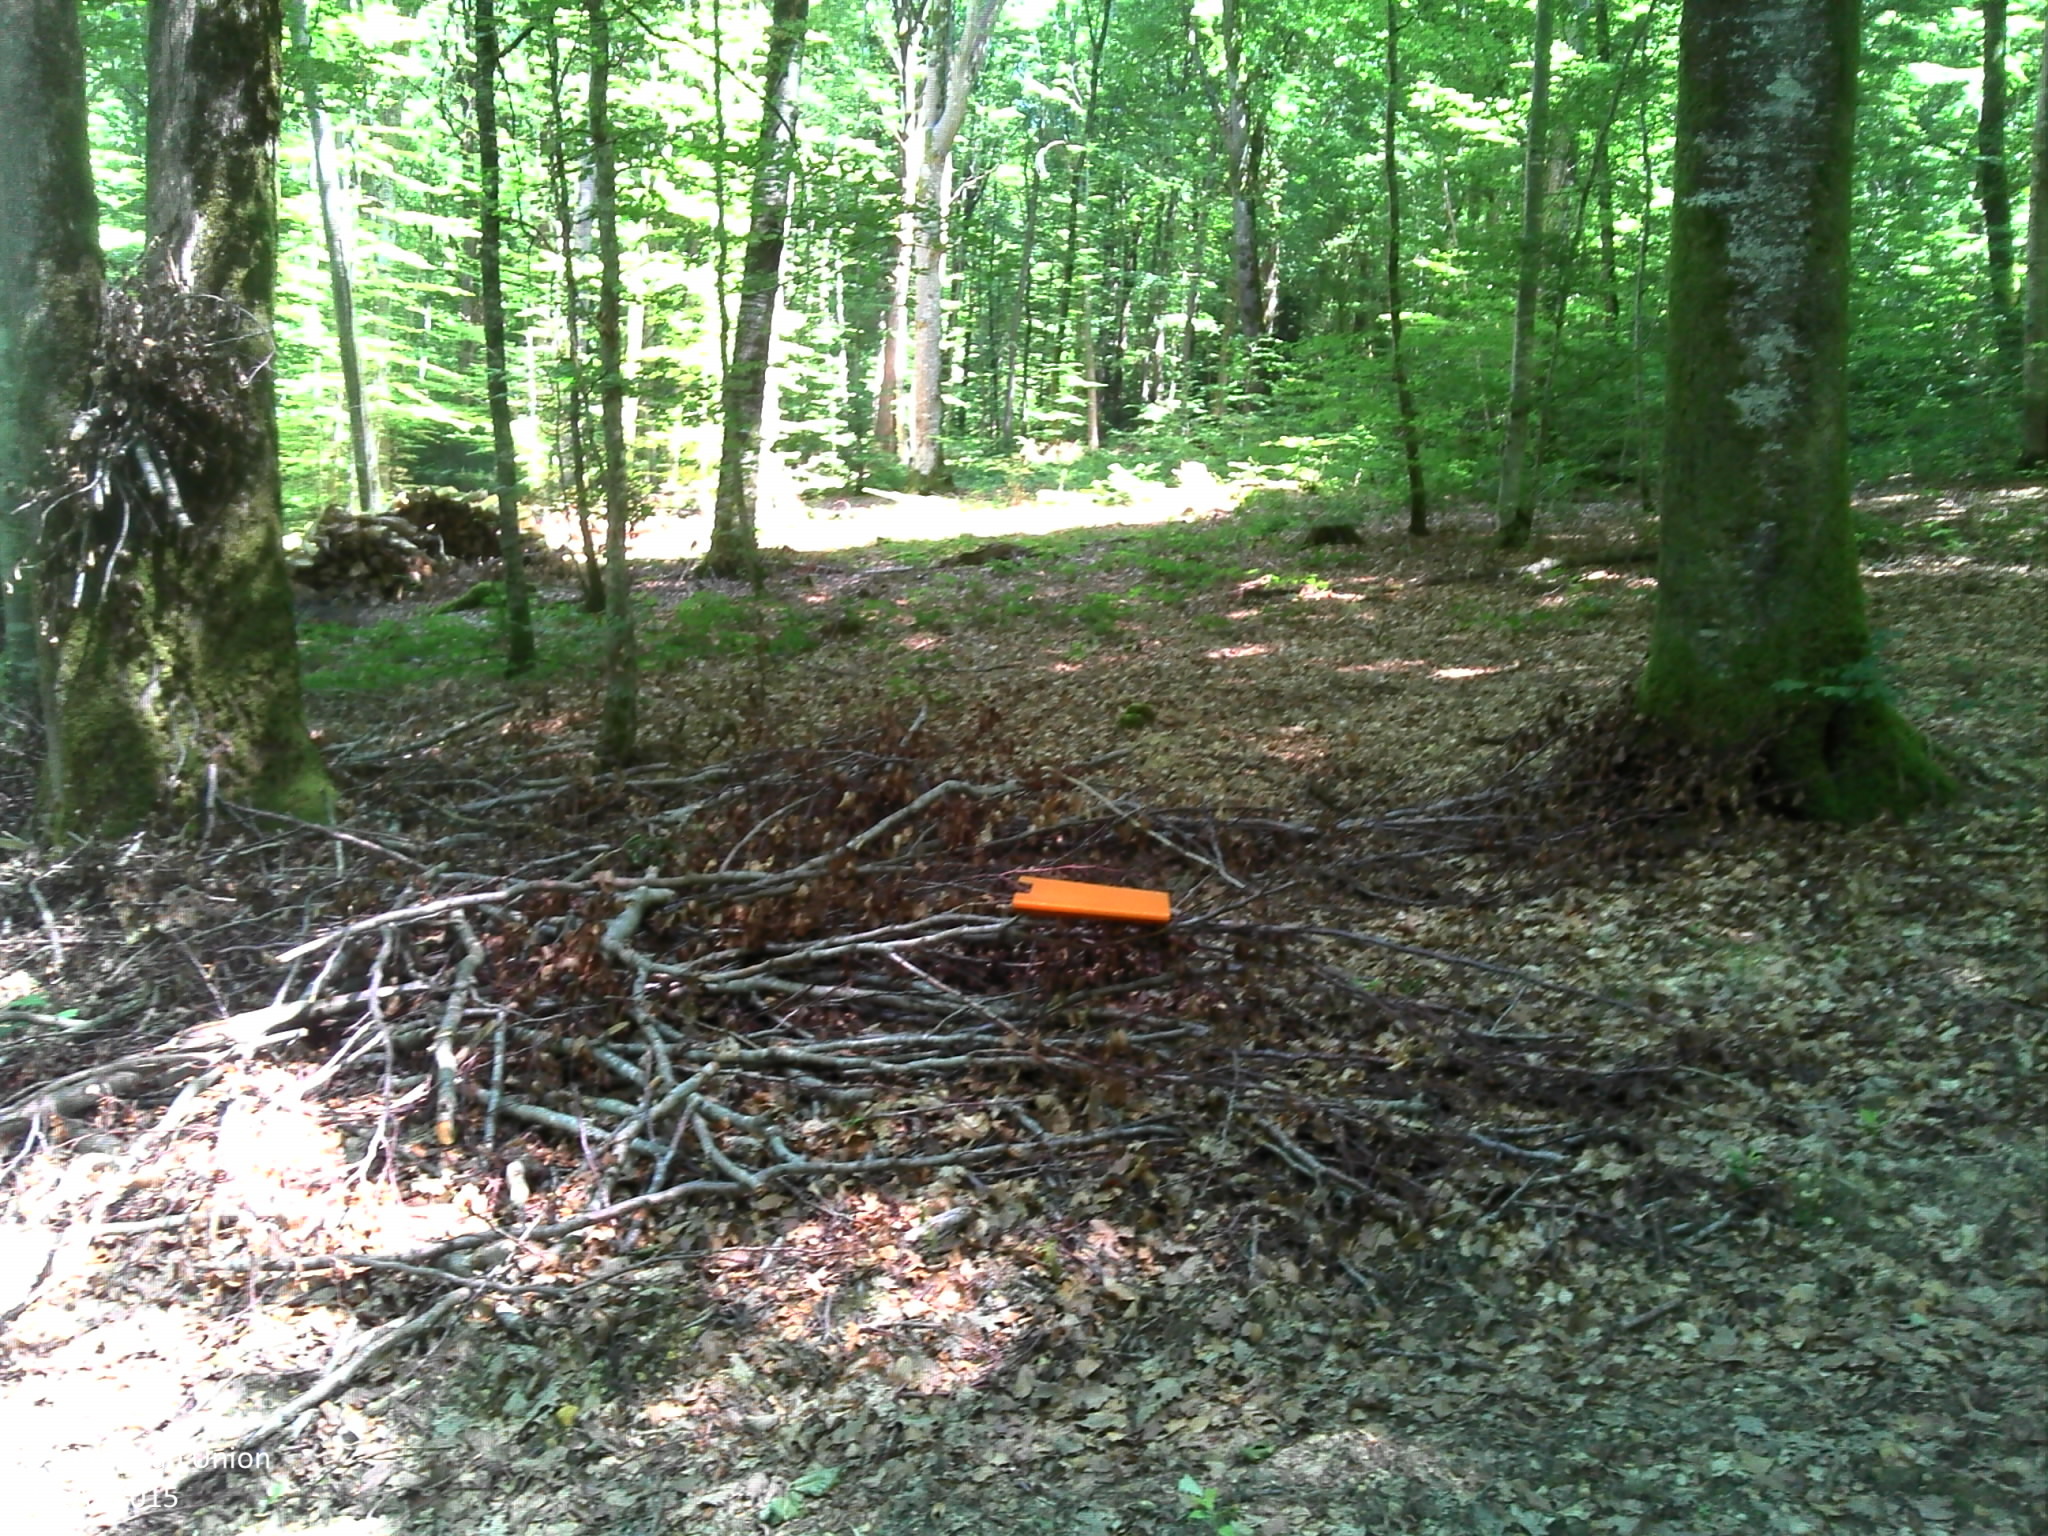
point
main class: Woodland
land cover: Broadleaved woodland
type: beech forest
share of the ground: > 75 %
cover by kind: broadleaved forest trees 90 %, consolidated bare surface 10 %
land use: Forestry
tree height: > 5 m
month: June
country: FR
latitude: 47.4723
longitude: 6.1670
